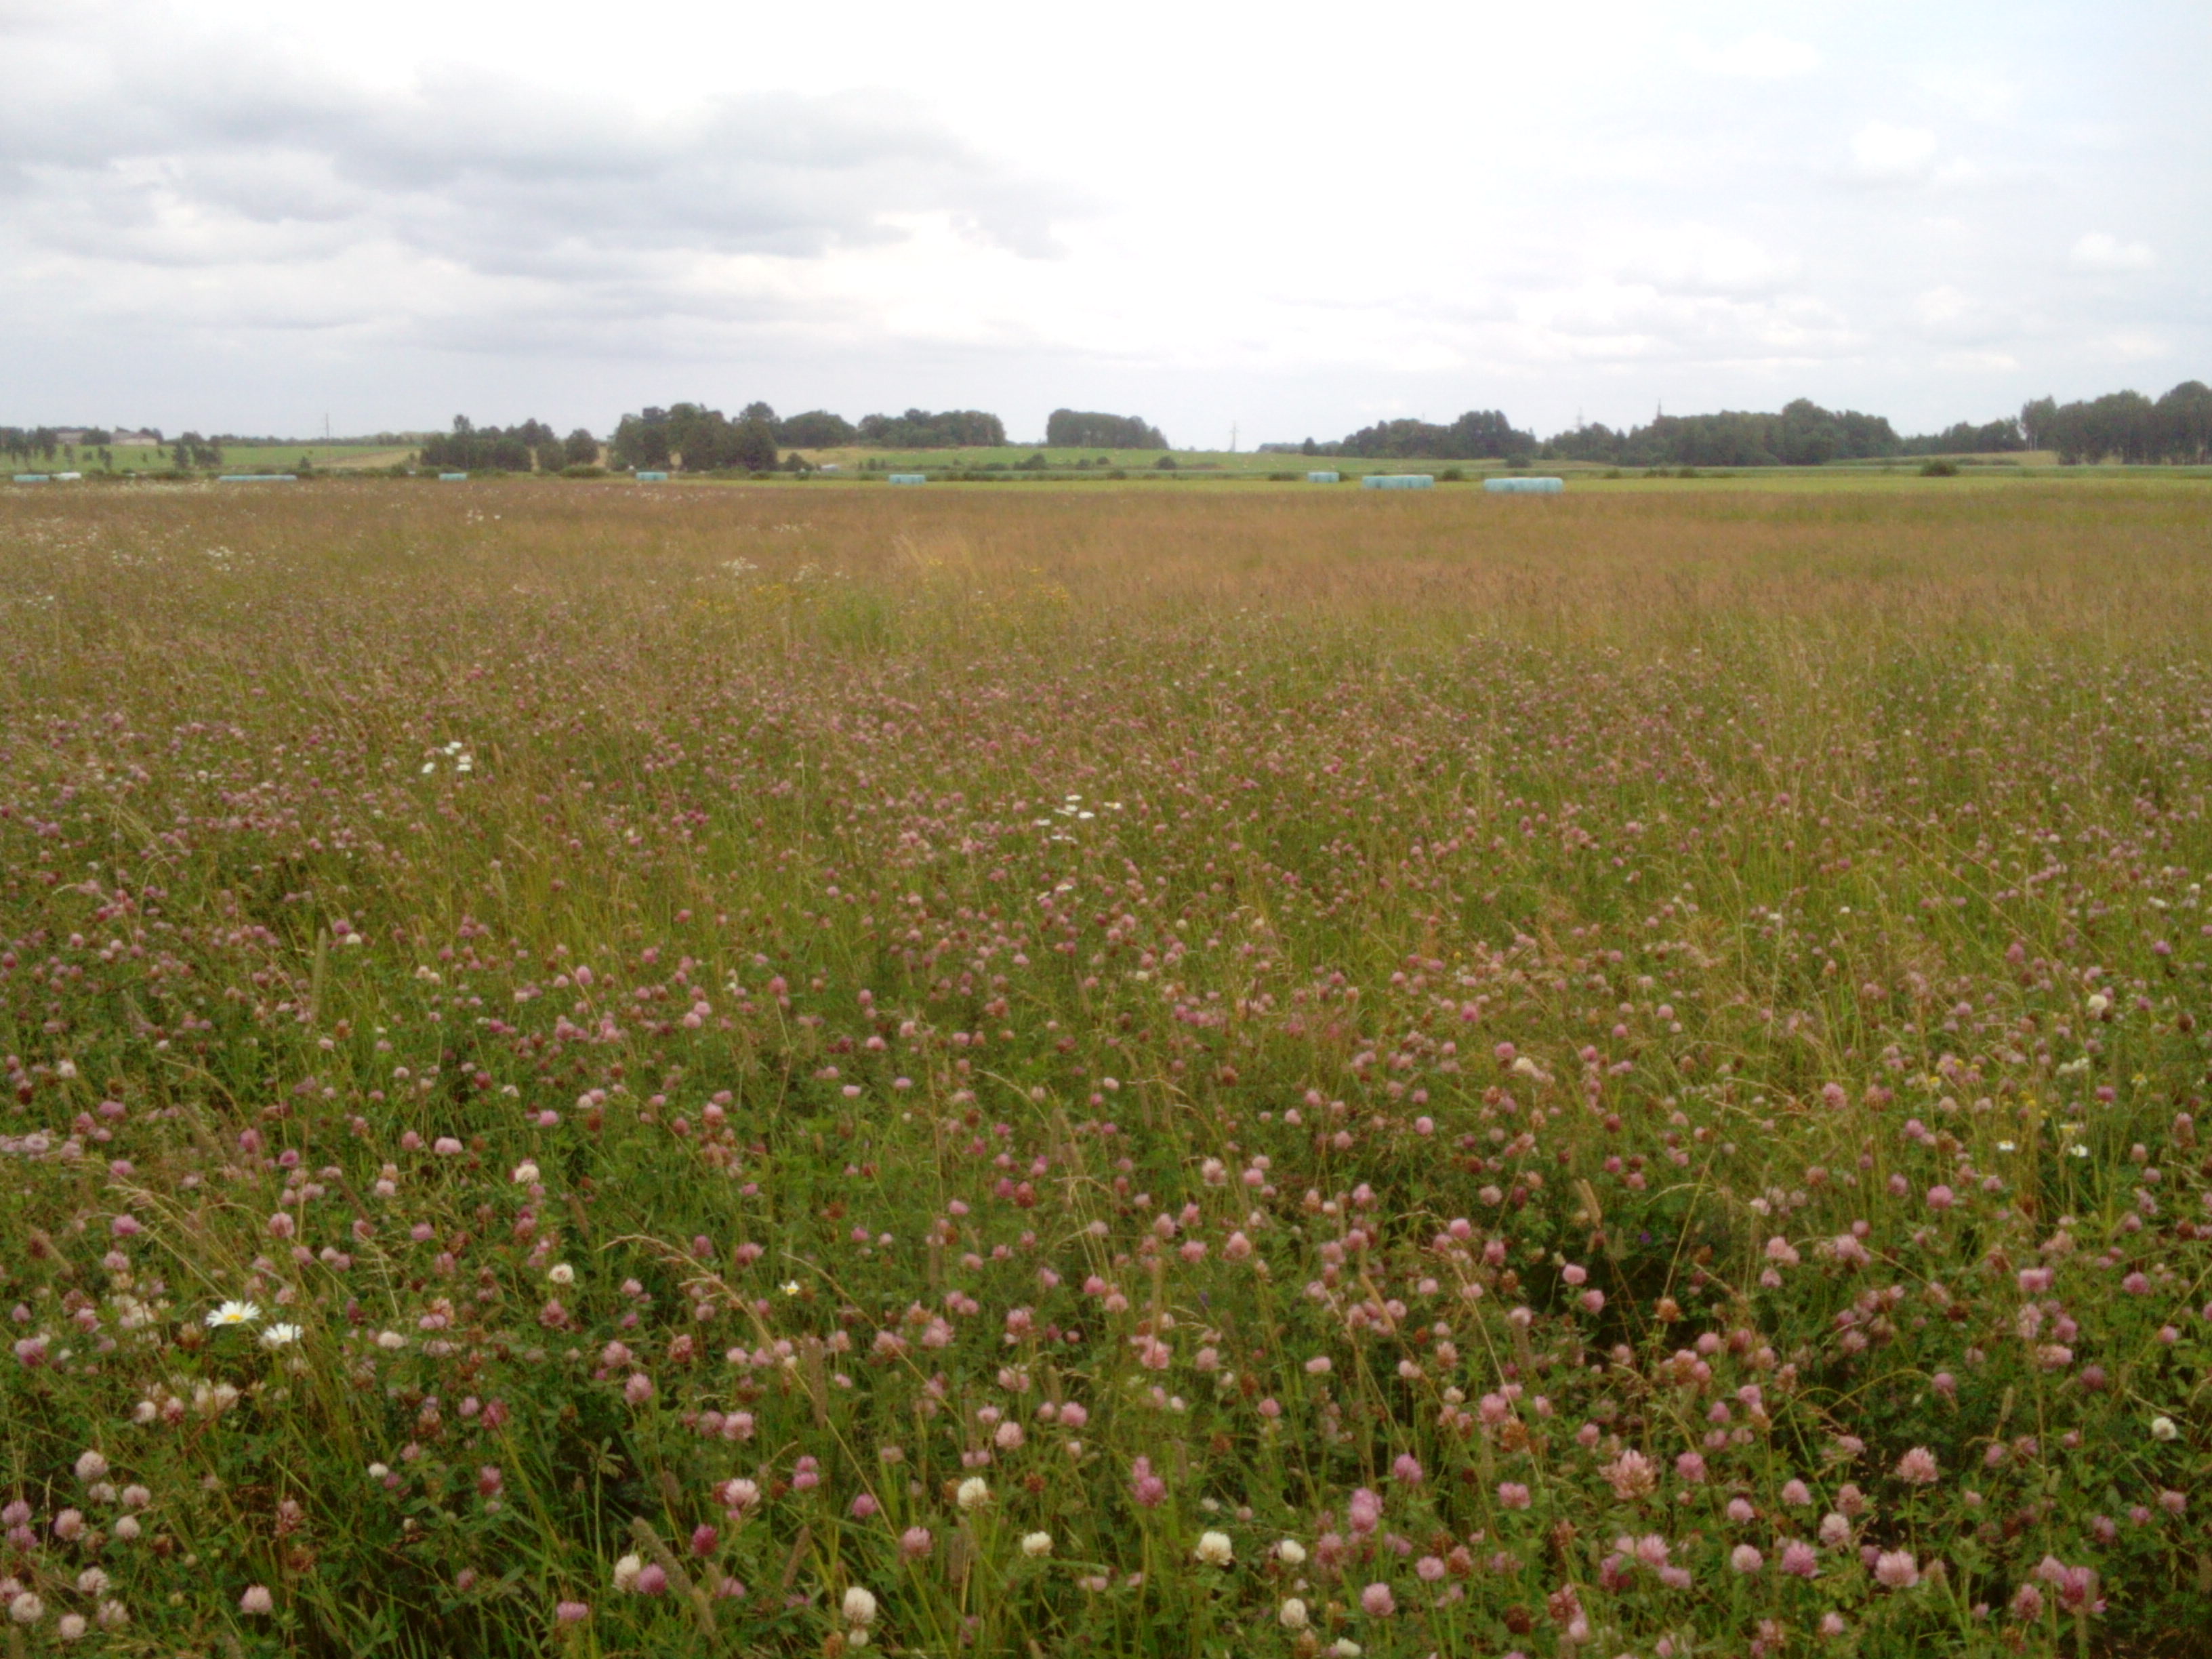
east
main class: Grassland
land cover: Grassland without tree/shrub cover
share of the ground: > 75 %
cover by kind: herbaceous plants 100 %
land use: Agriculture (excluding fallow land and kitchen gardens)
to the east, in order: Grassland without tree/shrub cover
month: July
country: LV
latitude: 56.9390
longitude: 22.1298
